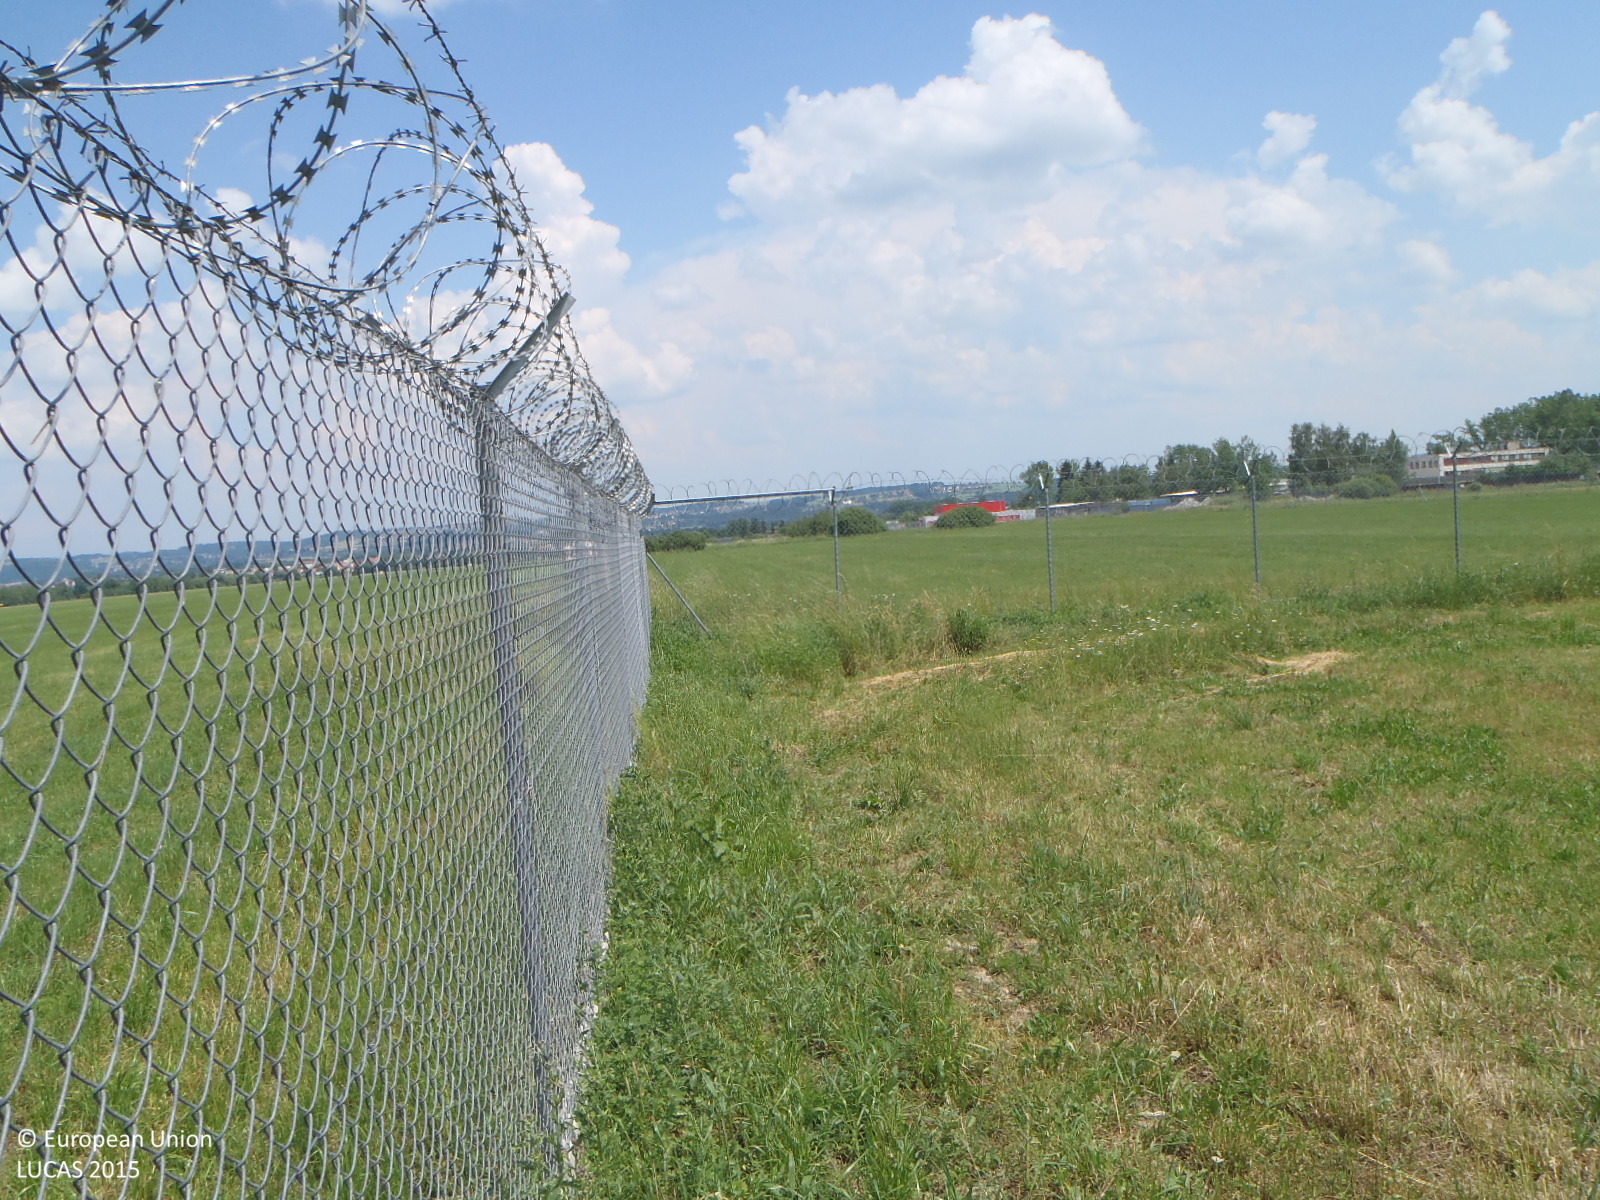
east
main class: Grassland
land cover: Grassland without tree/shrub cover
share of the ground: > 75 %
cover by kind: herbaceous plants 100 %
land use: Air transport
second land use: Community services
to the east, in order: Grassland without tree/shrub cover
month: June
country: CZ
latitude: 48.9451
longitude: 14.4385
